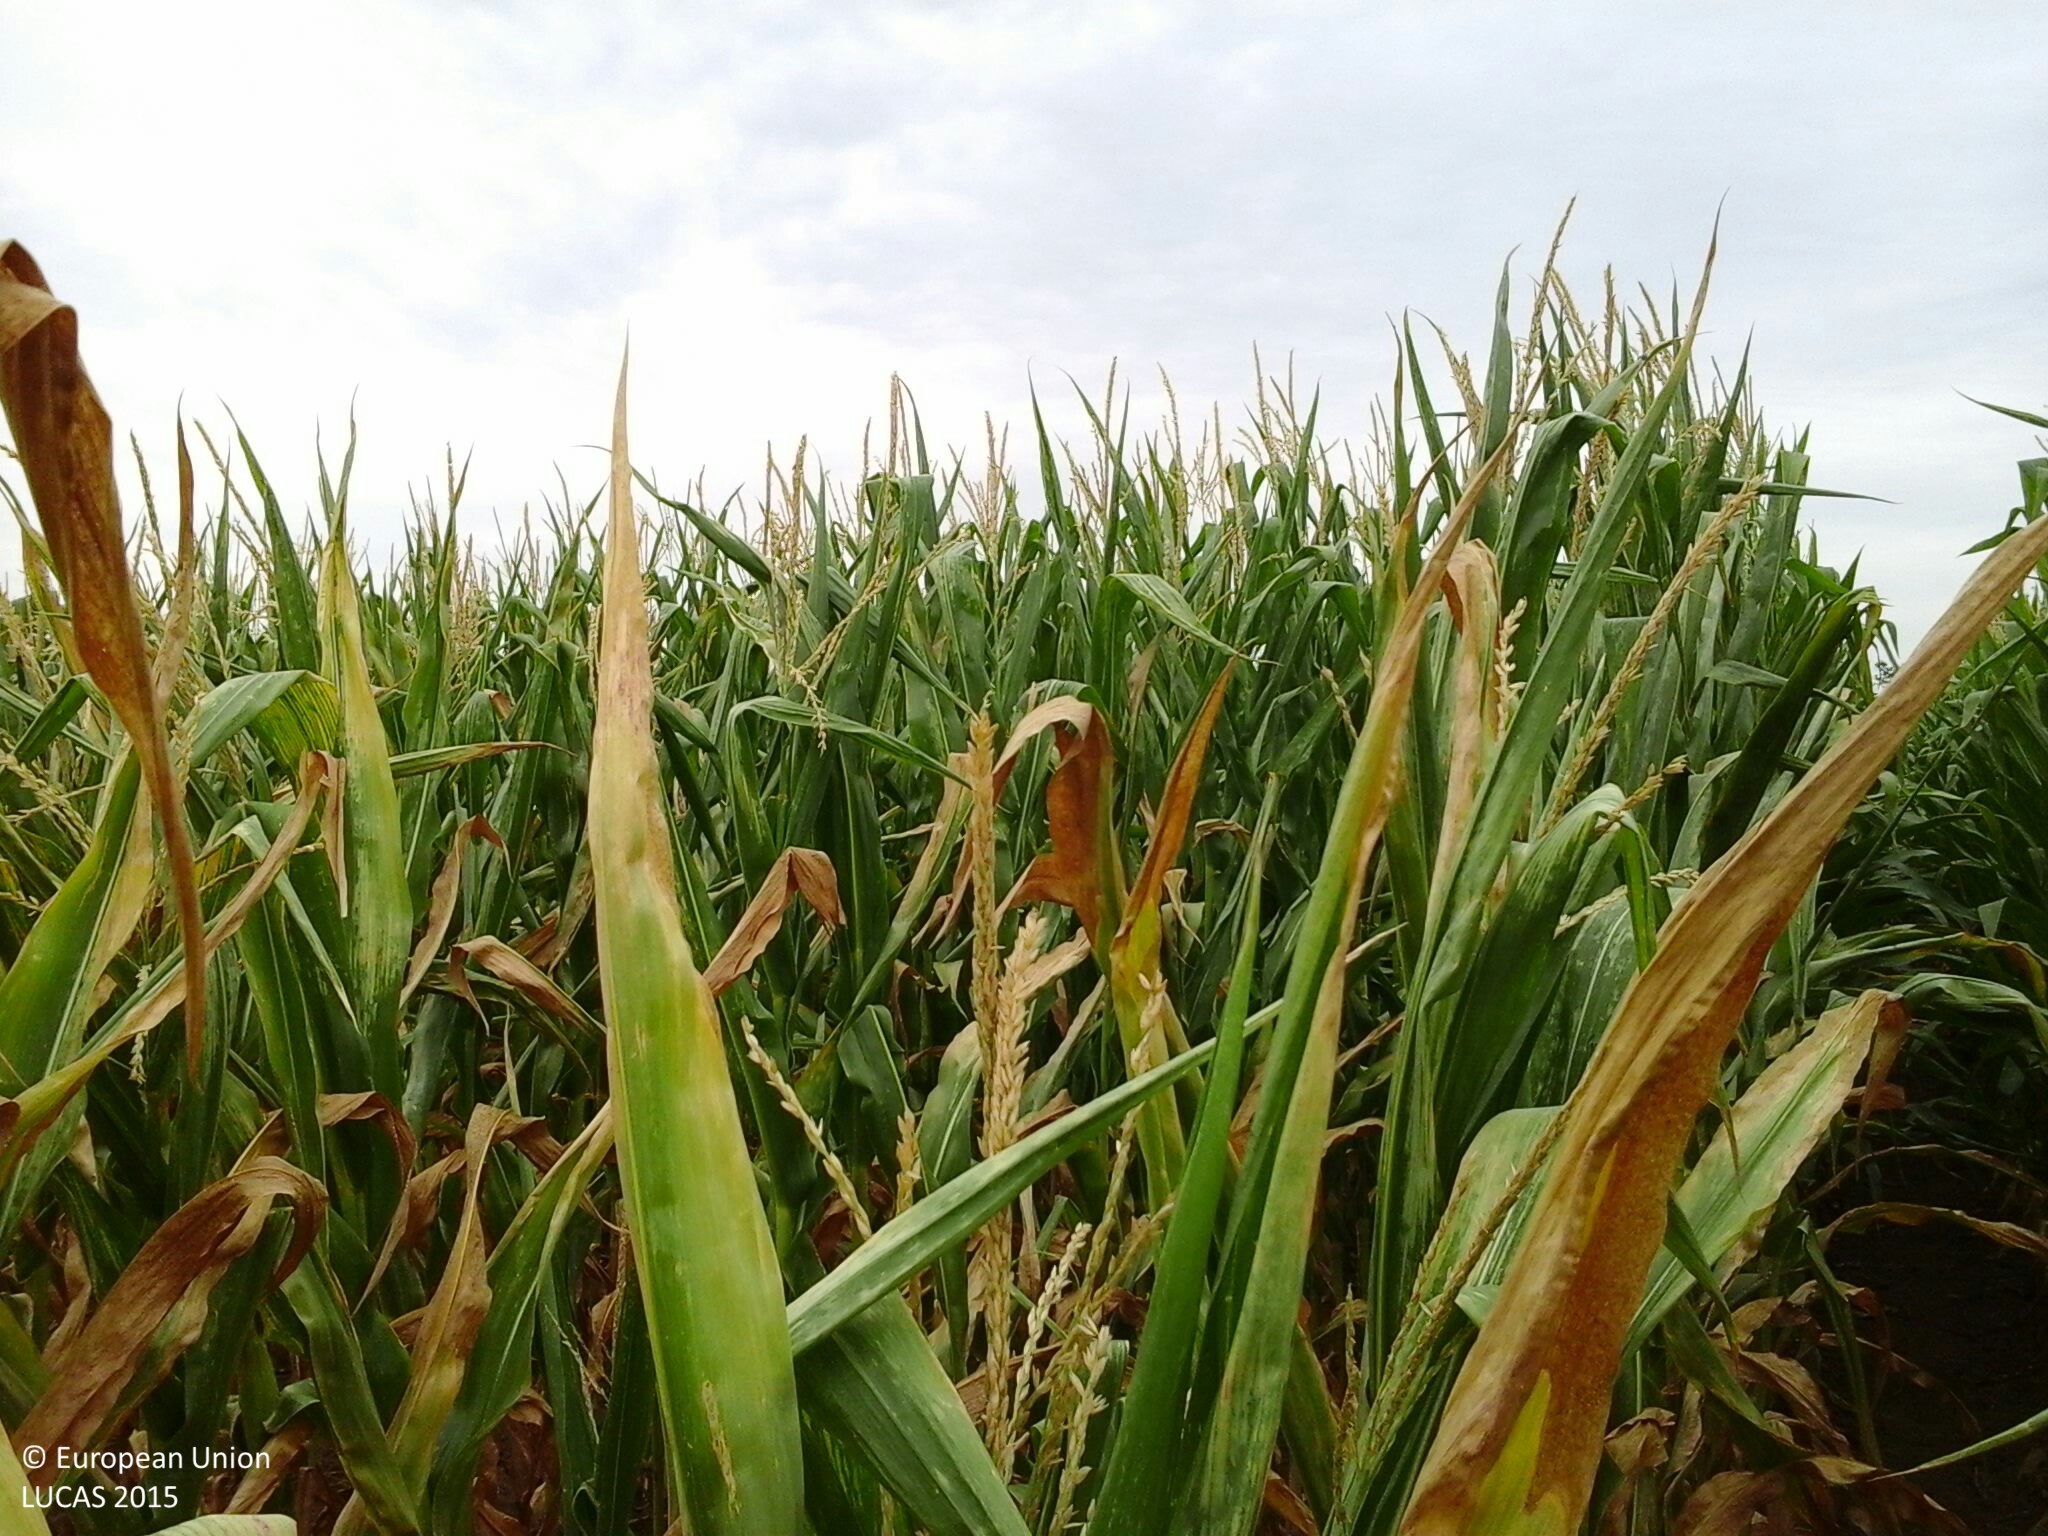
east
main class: Cropland
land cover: Maize
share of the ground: > 75 %
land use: Agriculture (excluding fallow land and kitchen gardens)
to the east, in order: Maize; Tracks; Broadleaved woodland; Sunflower; Grassland without tree/shrub cover; Ditches and canals; Grassland without tree/shrub cover; Common wheat
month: July
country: HU
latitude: 47.8792
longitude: 21.4498
